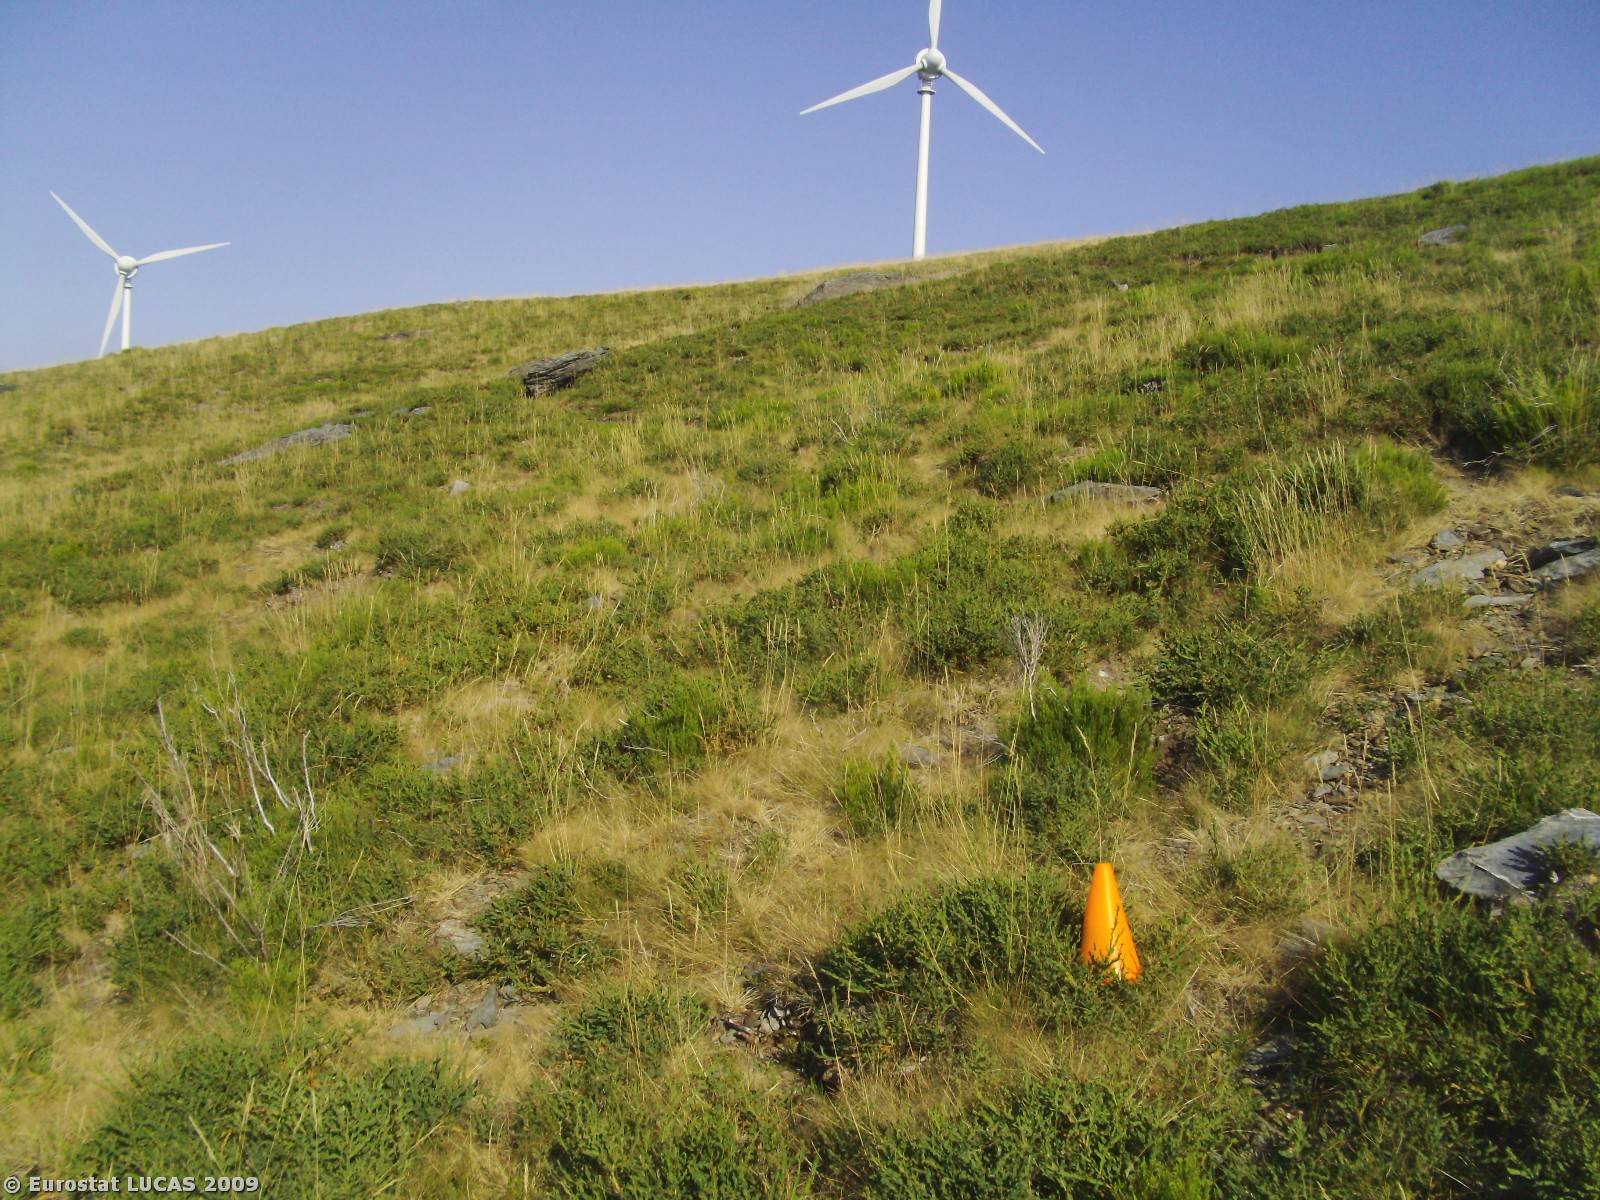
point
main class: Shrubland
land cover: Shrubland without tree cover
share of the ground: > 75 %
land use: Nature reserves
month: August
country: PT
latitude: 41.2991
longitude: -7.9178
